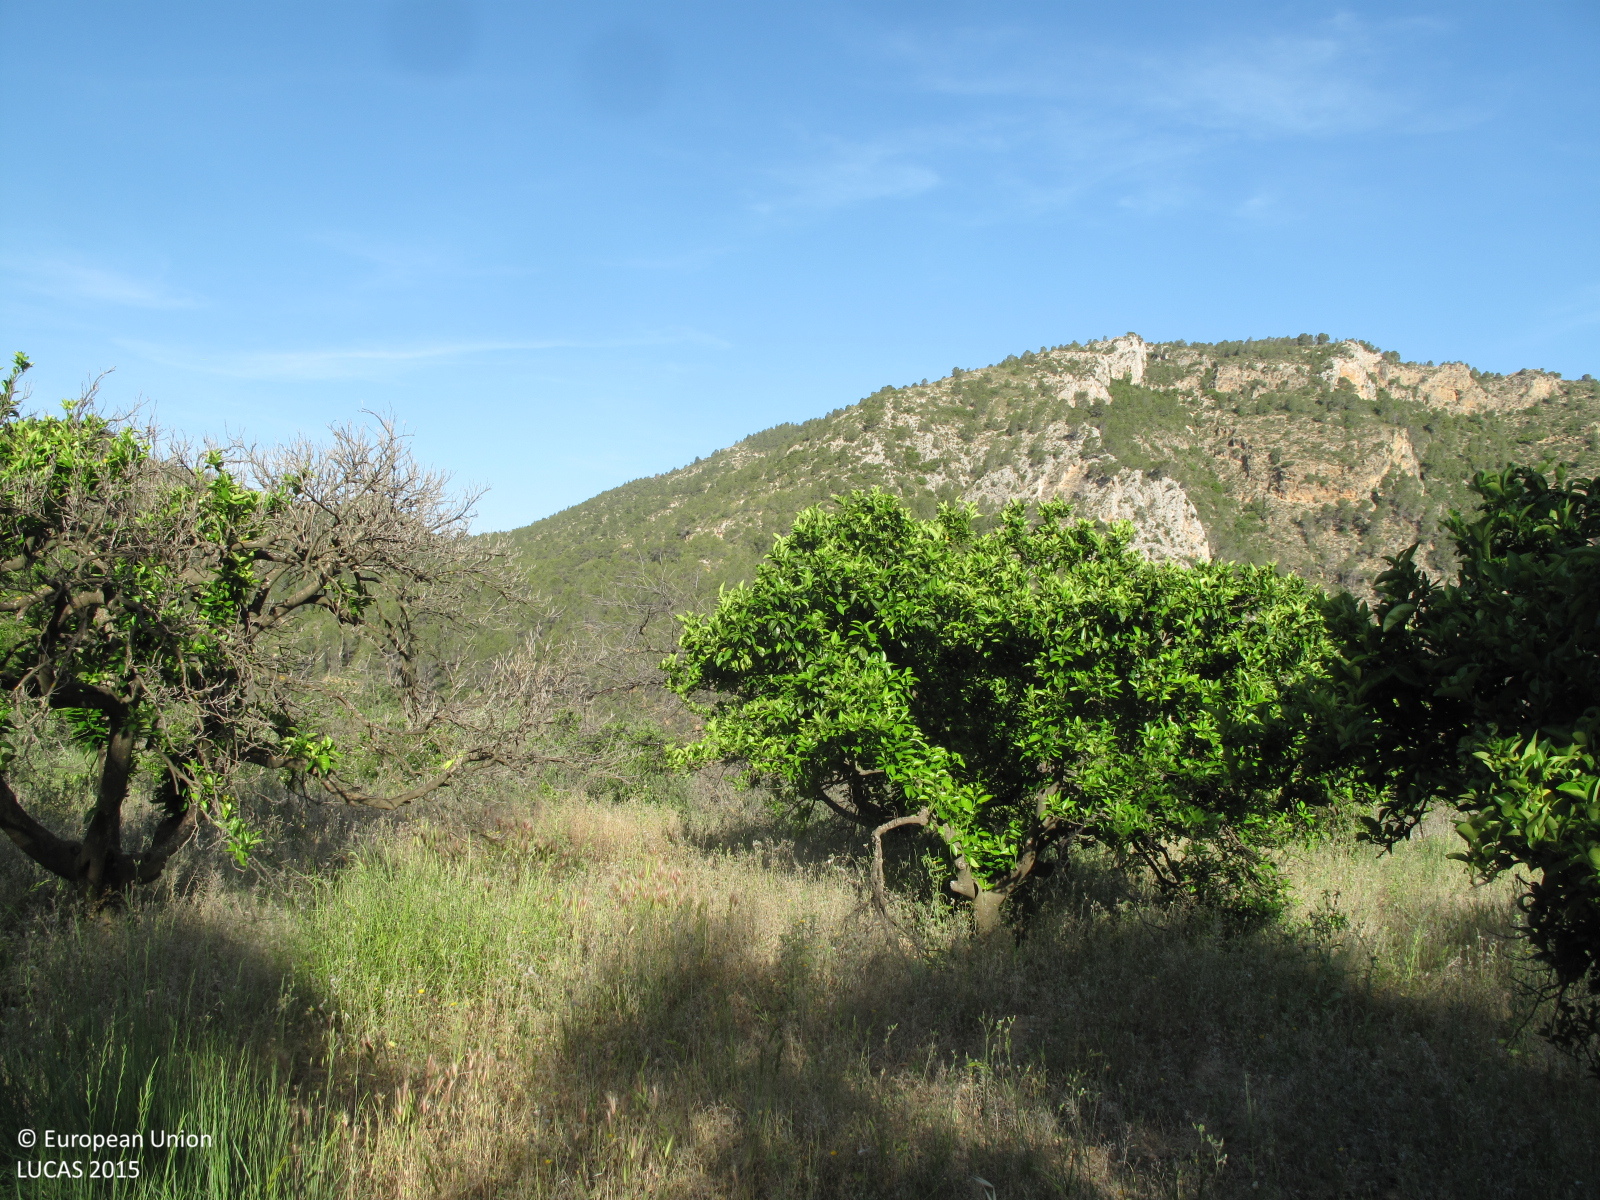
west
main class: Cropland
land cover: Oranges
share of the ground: 10 - 25 %
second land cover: Spontaneously vegetated surfaces
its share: > 75 %
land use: Agriculture (excluding fallow land and kitchen gardens)
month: May
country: ES
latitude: 39.1080
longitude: -0.7615
